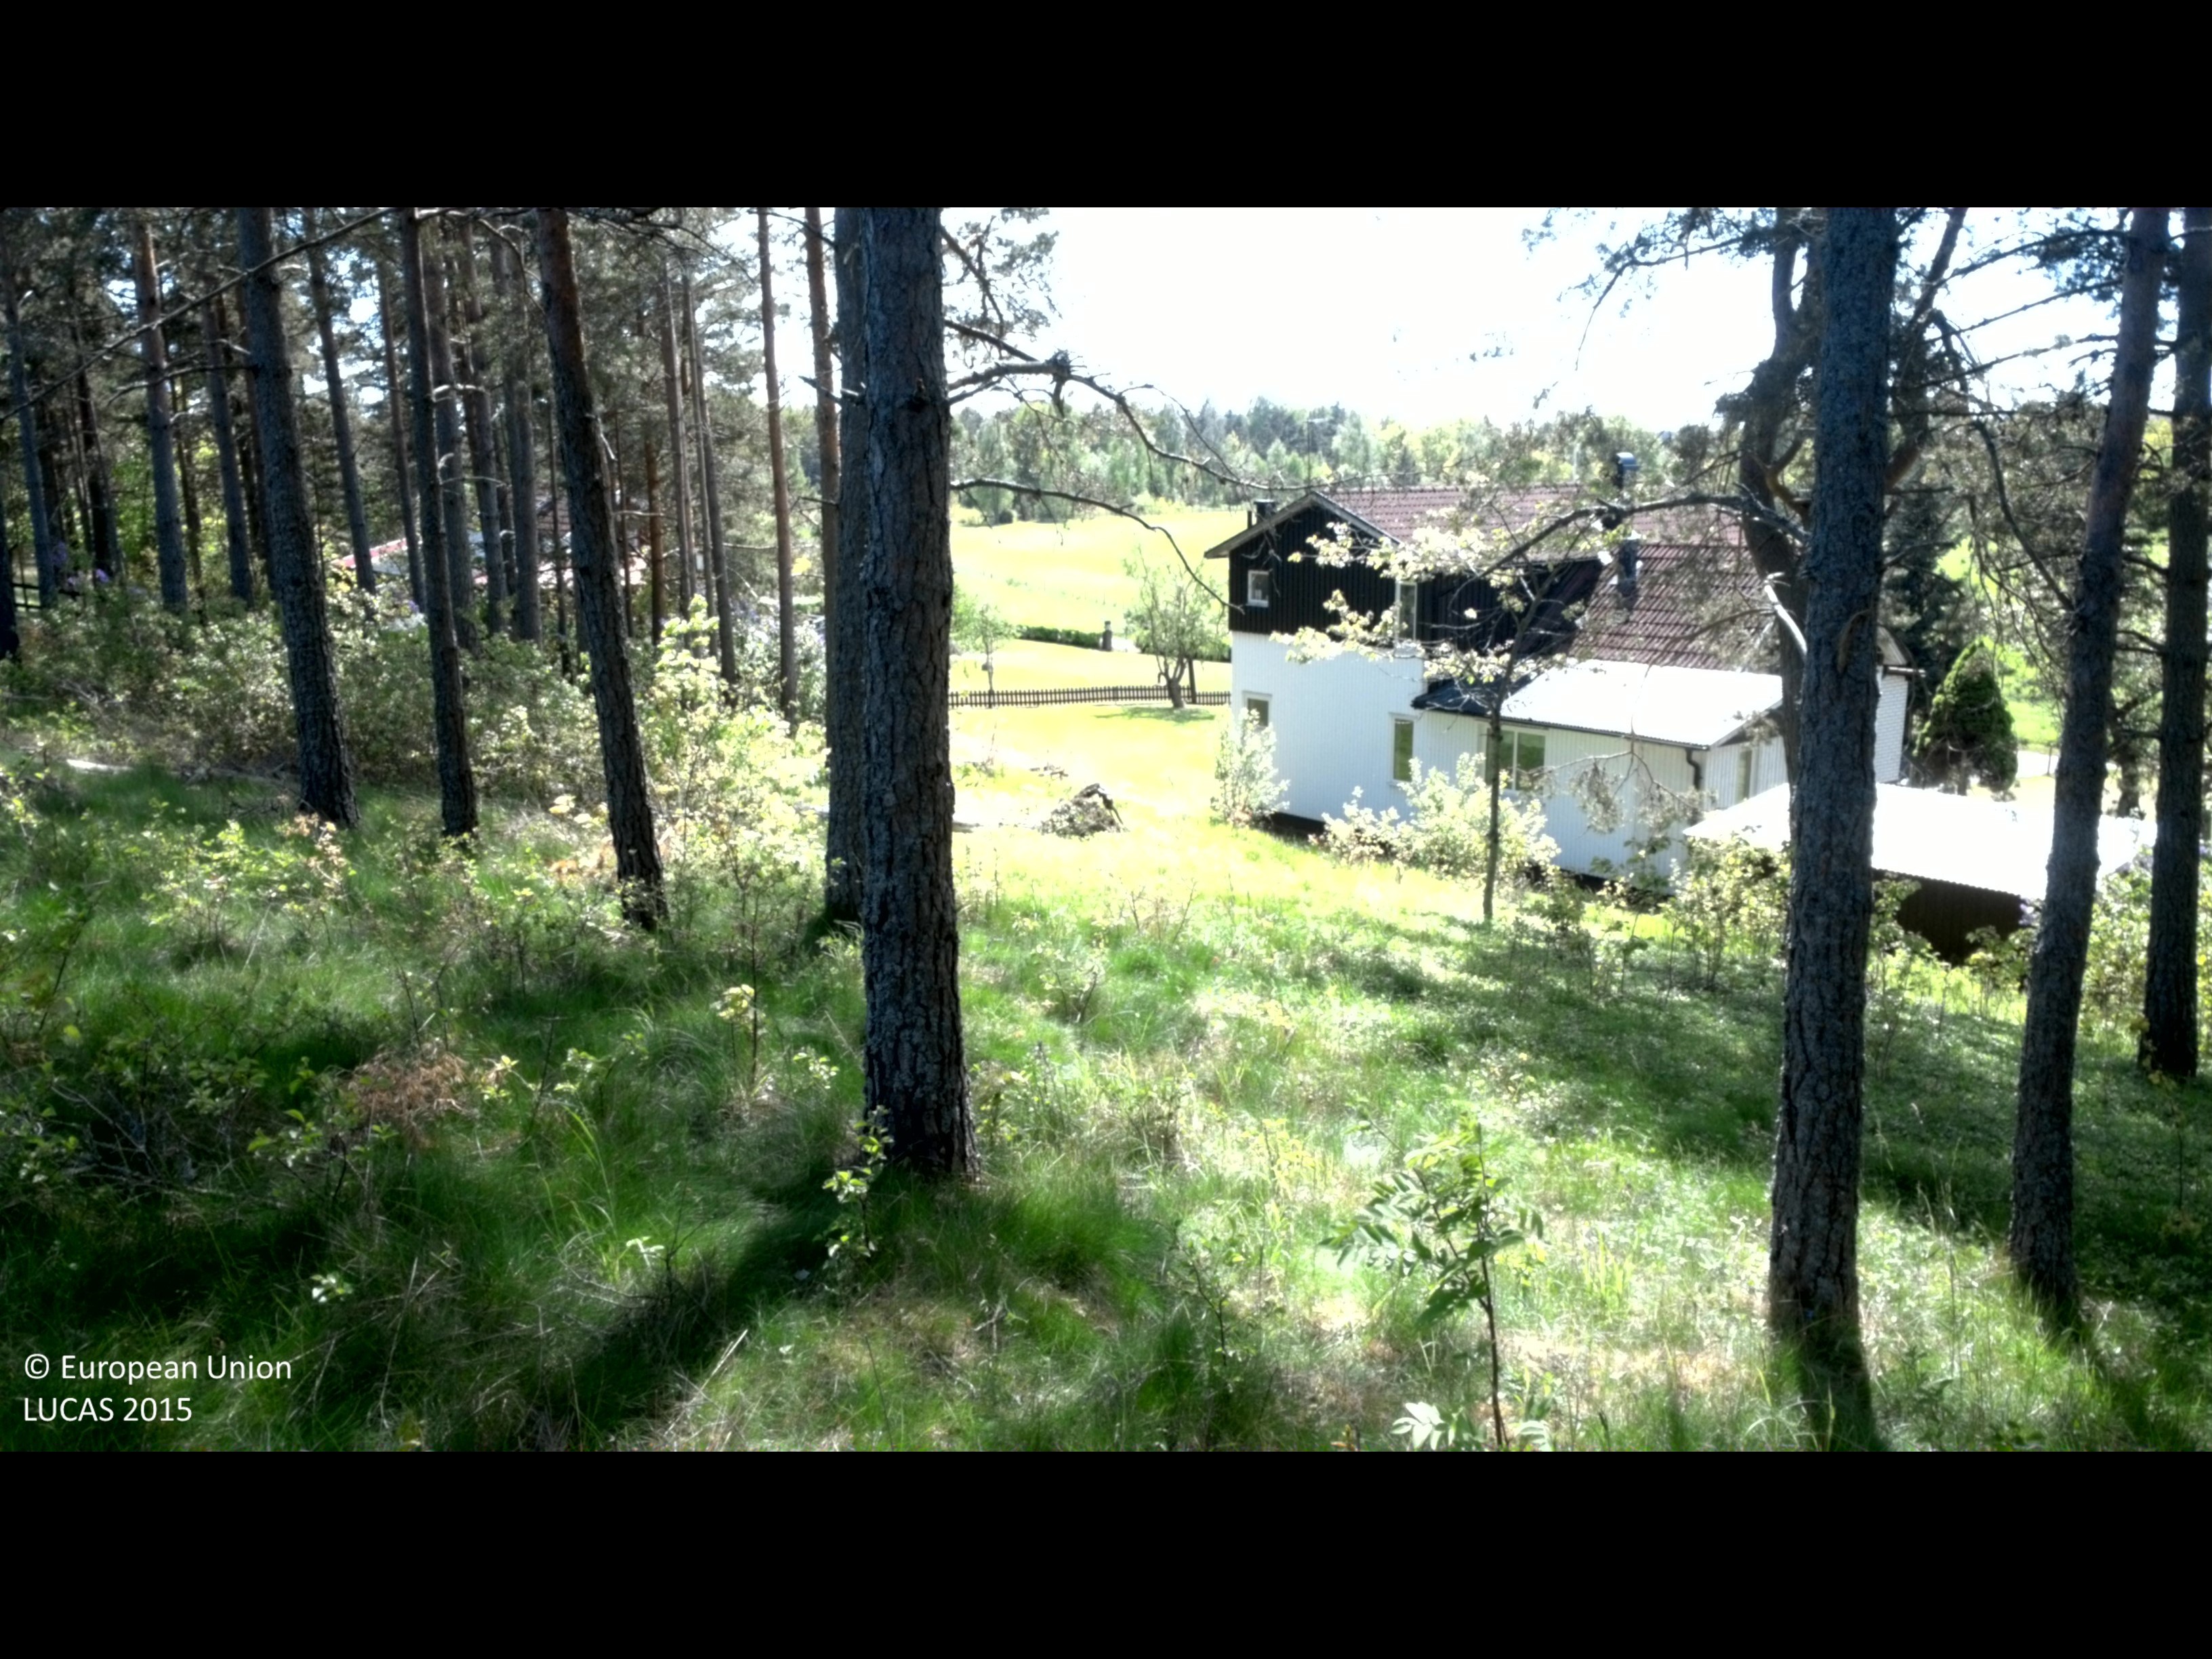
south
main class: Woodland
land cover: Pine dominated coniferous woodland
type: boreal forest
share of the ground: 25 - 50 %
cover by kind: coniferous forest trees 60 %, shrubs 15 %, herbaceous plants 15 %, broadleaved forest trees 10 %
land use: Forestry
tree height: > 5 m
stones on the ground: < 10 %
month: May
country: SE
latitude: 57.2964
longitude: 16.2886
